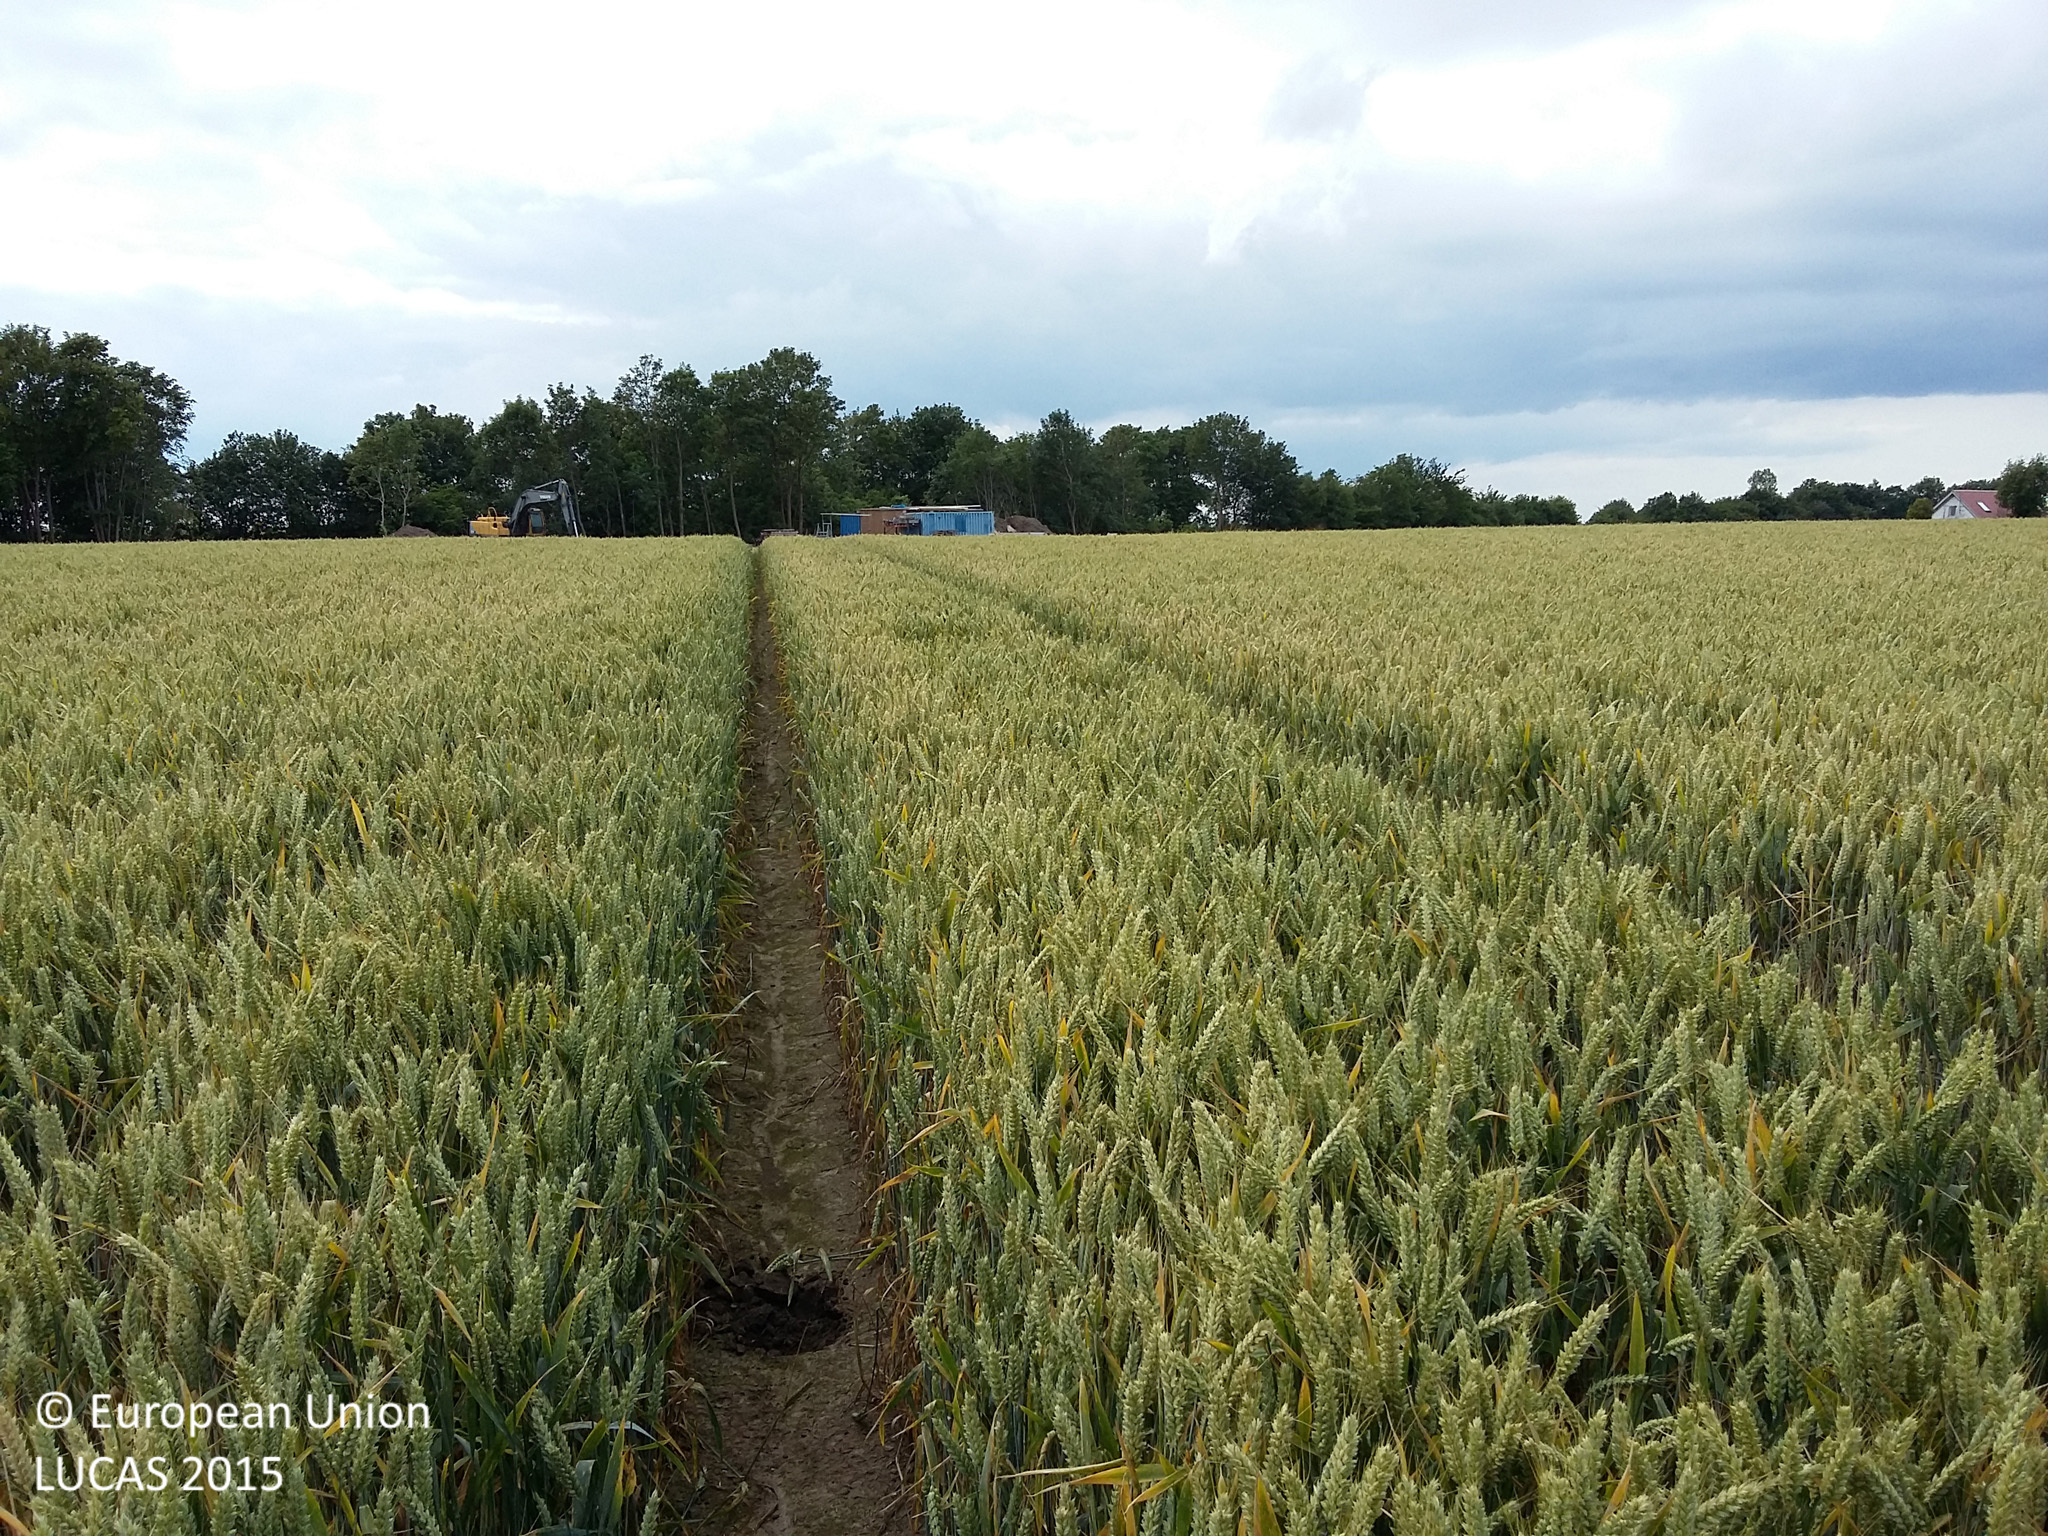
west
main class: Cropland
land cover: Common wheat
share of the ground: > 75 %
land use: Agriculture (excluding fallow land and kitchen gardens)
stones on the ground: < 10 %
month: July
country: DK
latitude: 55.5162
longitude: 11.2816
